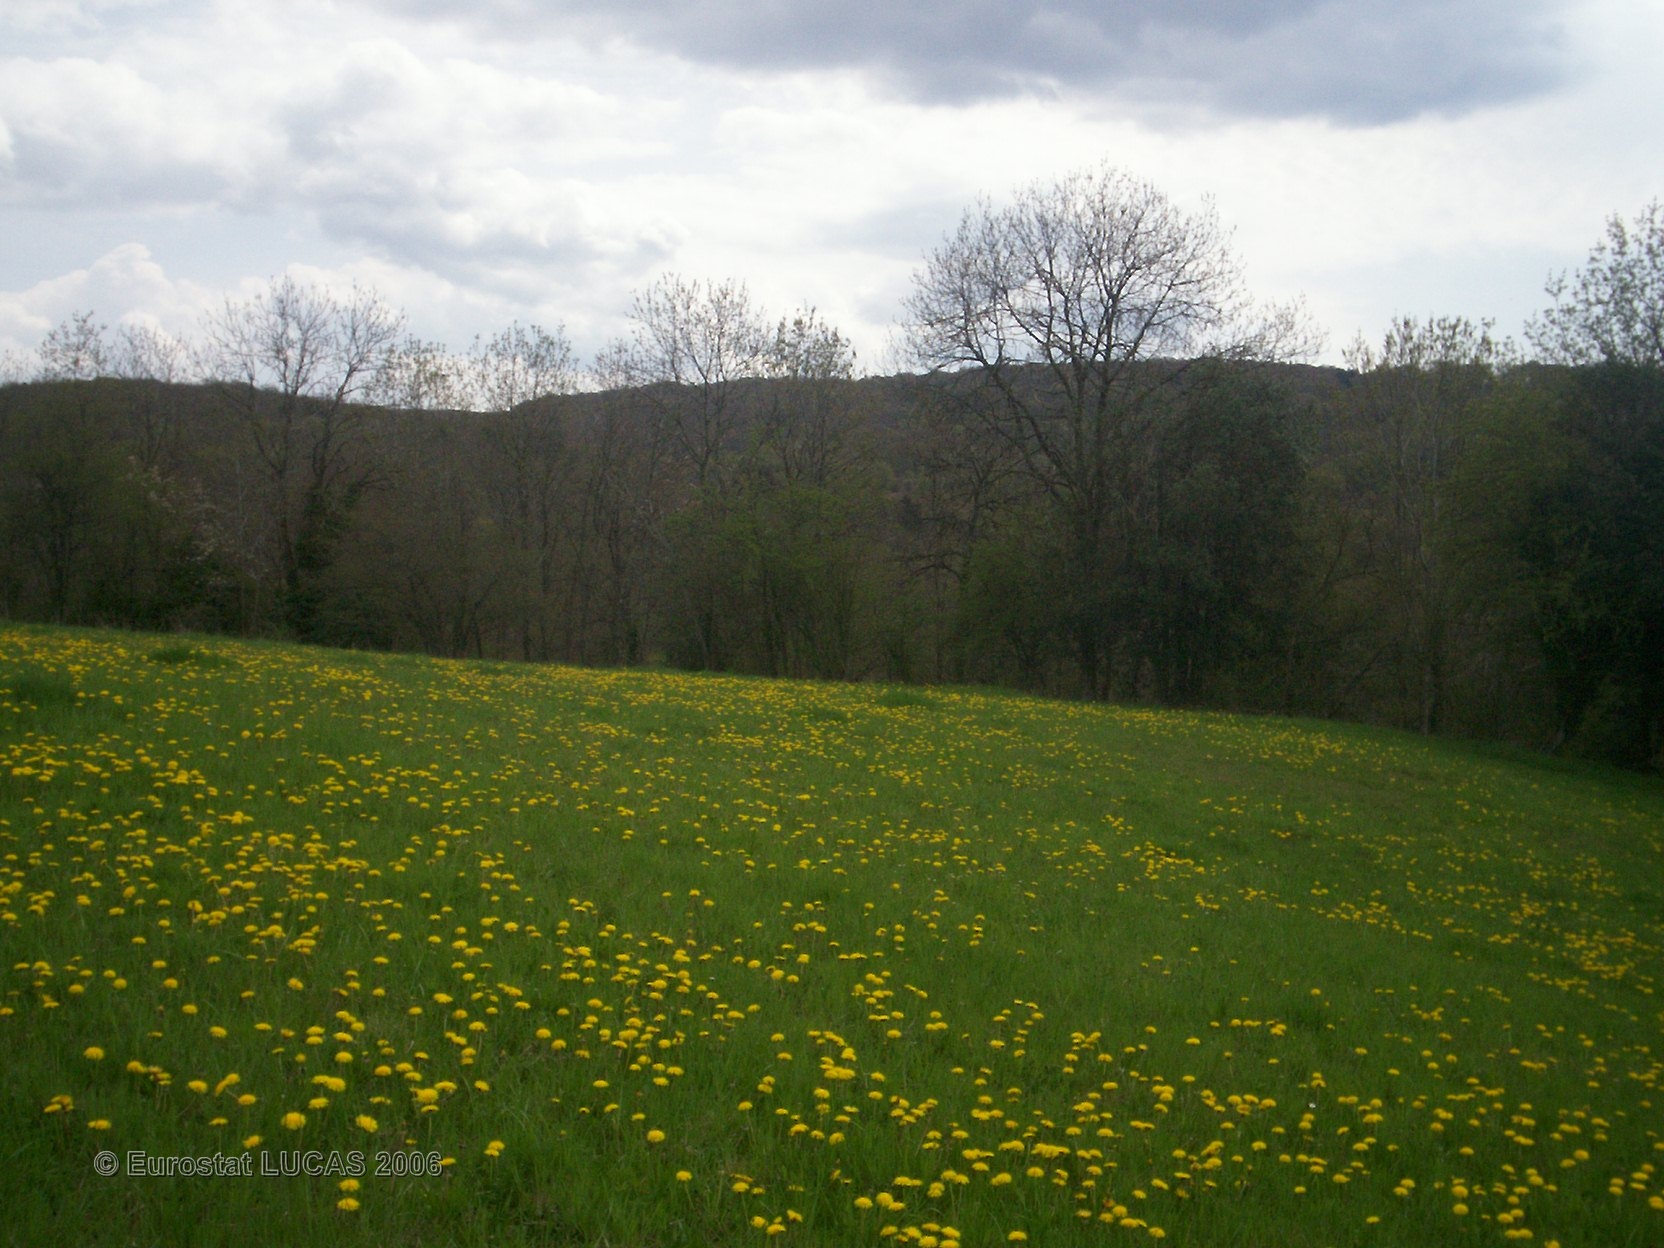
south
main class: Grassland
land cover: Grassland without tree/shrub cover
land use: Agriculture (excluding fallow land and kitchen gardens)
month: May
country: FR
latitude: 45.9355
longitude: 2.9179
